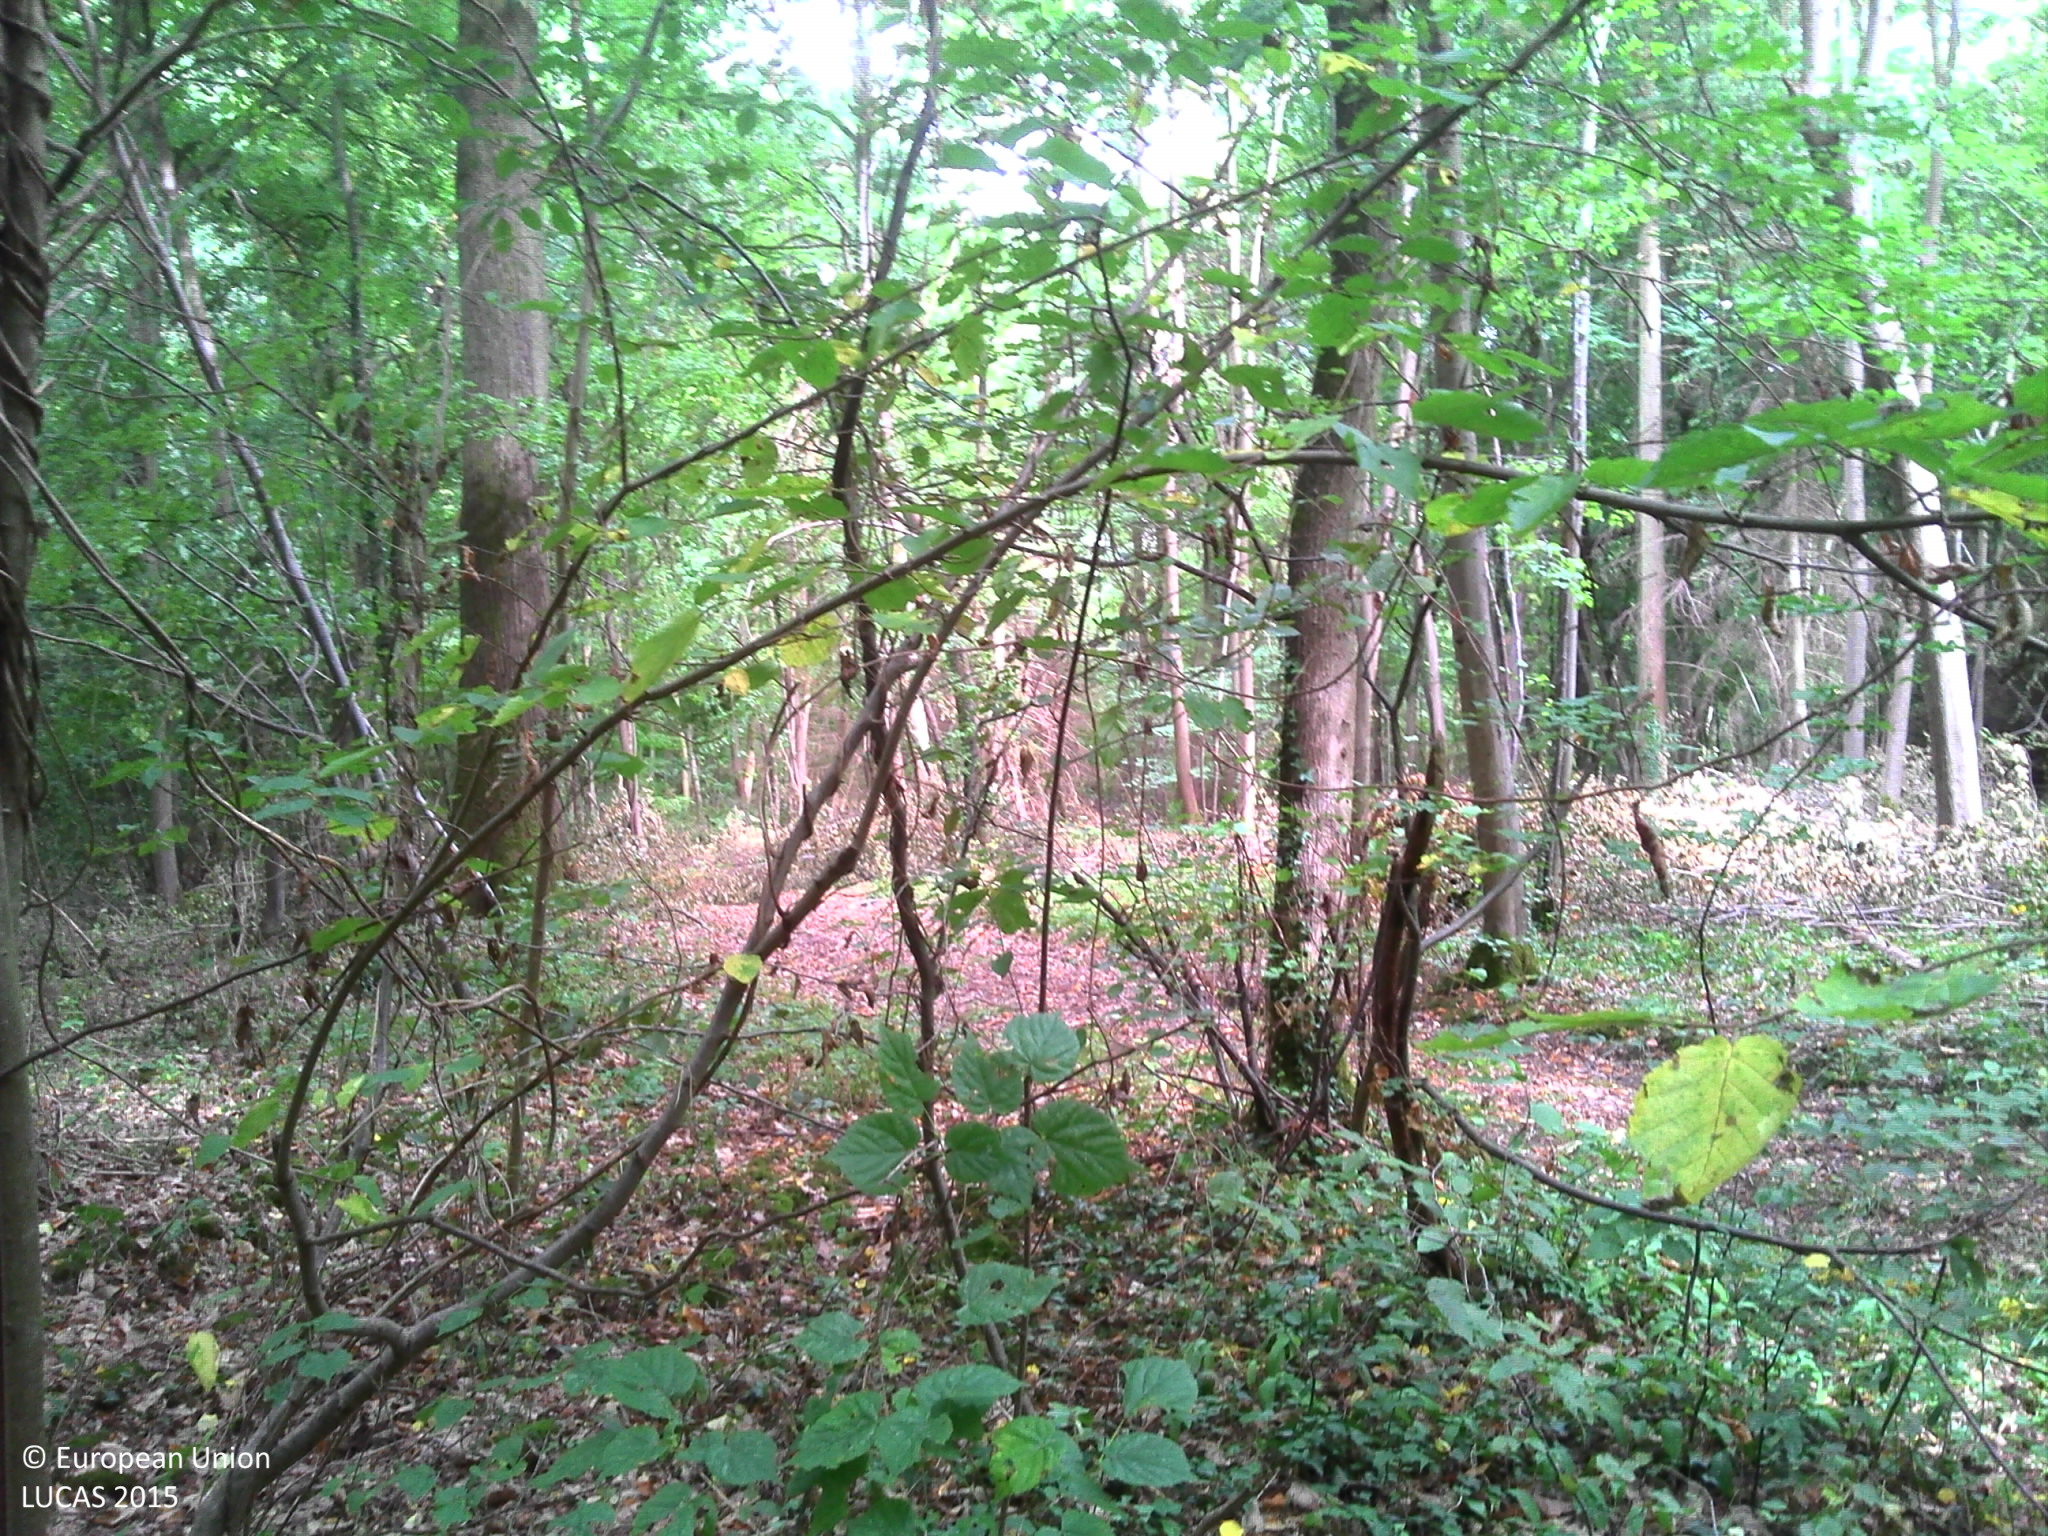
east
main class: Woodland
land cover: Broadleaved woodland
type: hemiboreal forest and nemoral coniferous forest and mixed broadleaved-coniferous forest
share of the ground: > 75 %
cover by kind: broadleaved forest trees 60 %, herbaceous plants 20 %, lichens and mosses 10 %, unconsolidated bare surface 10 %
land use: Forestry
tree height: > 5 m
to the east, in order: Broadleaved woodland; Tracks; Broadleaved woodland
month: August
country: FR
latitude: 48.9021
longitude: 2.6912
